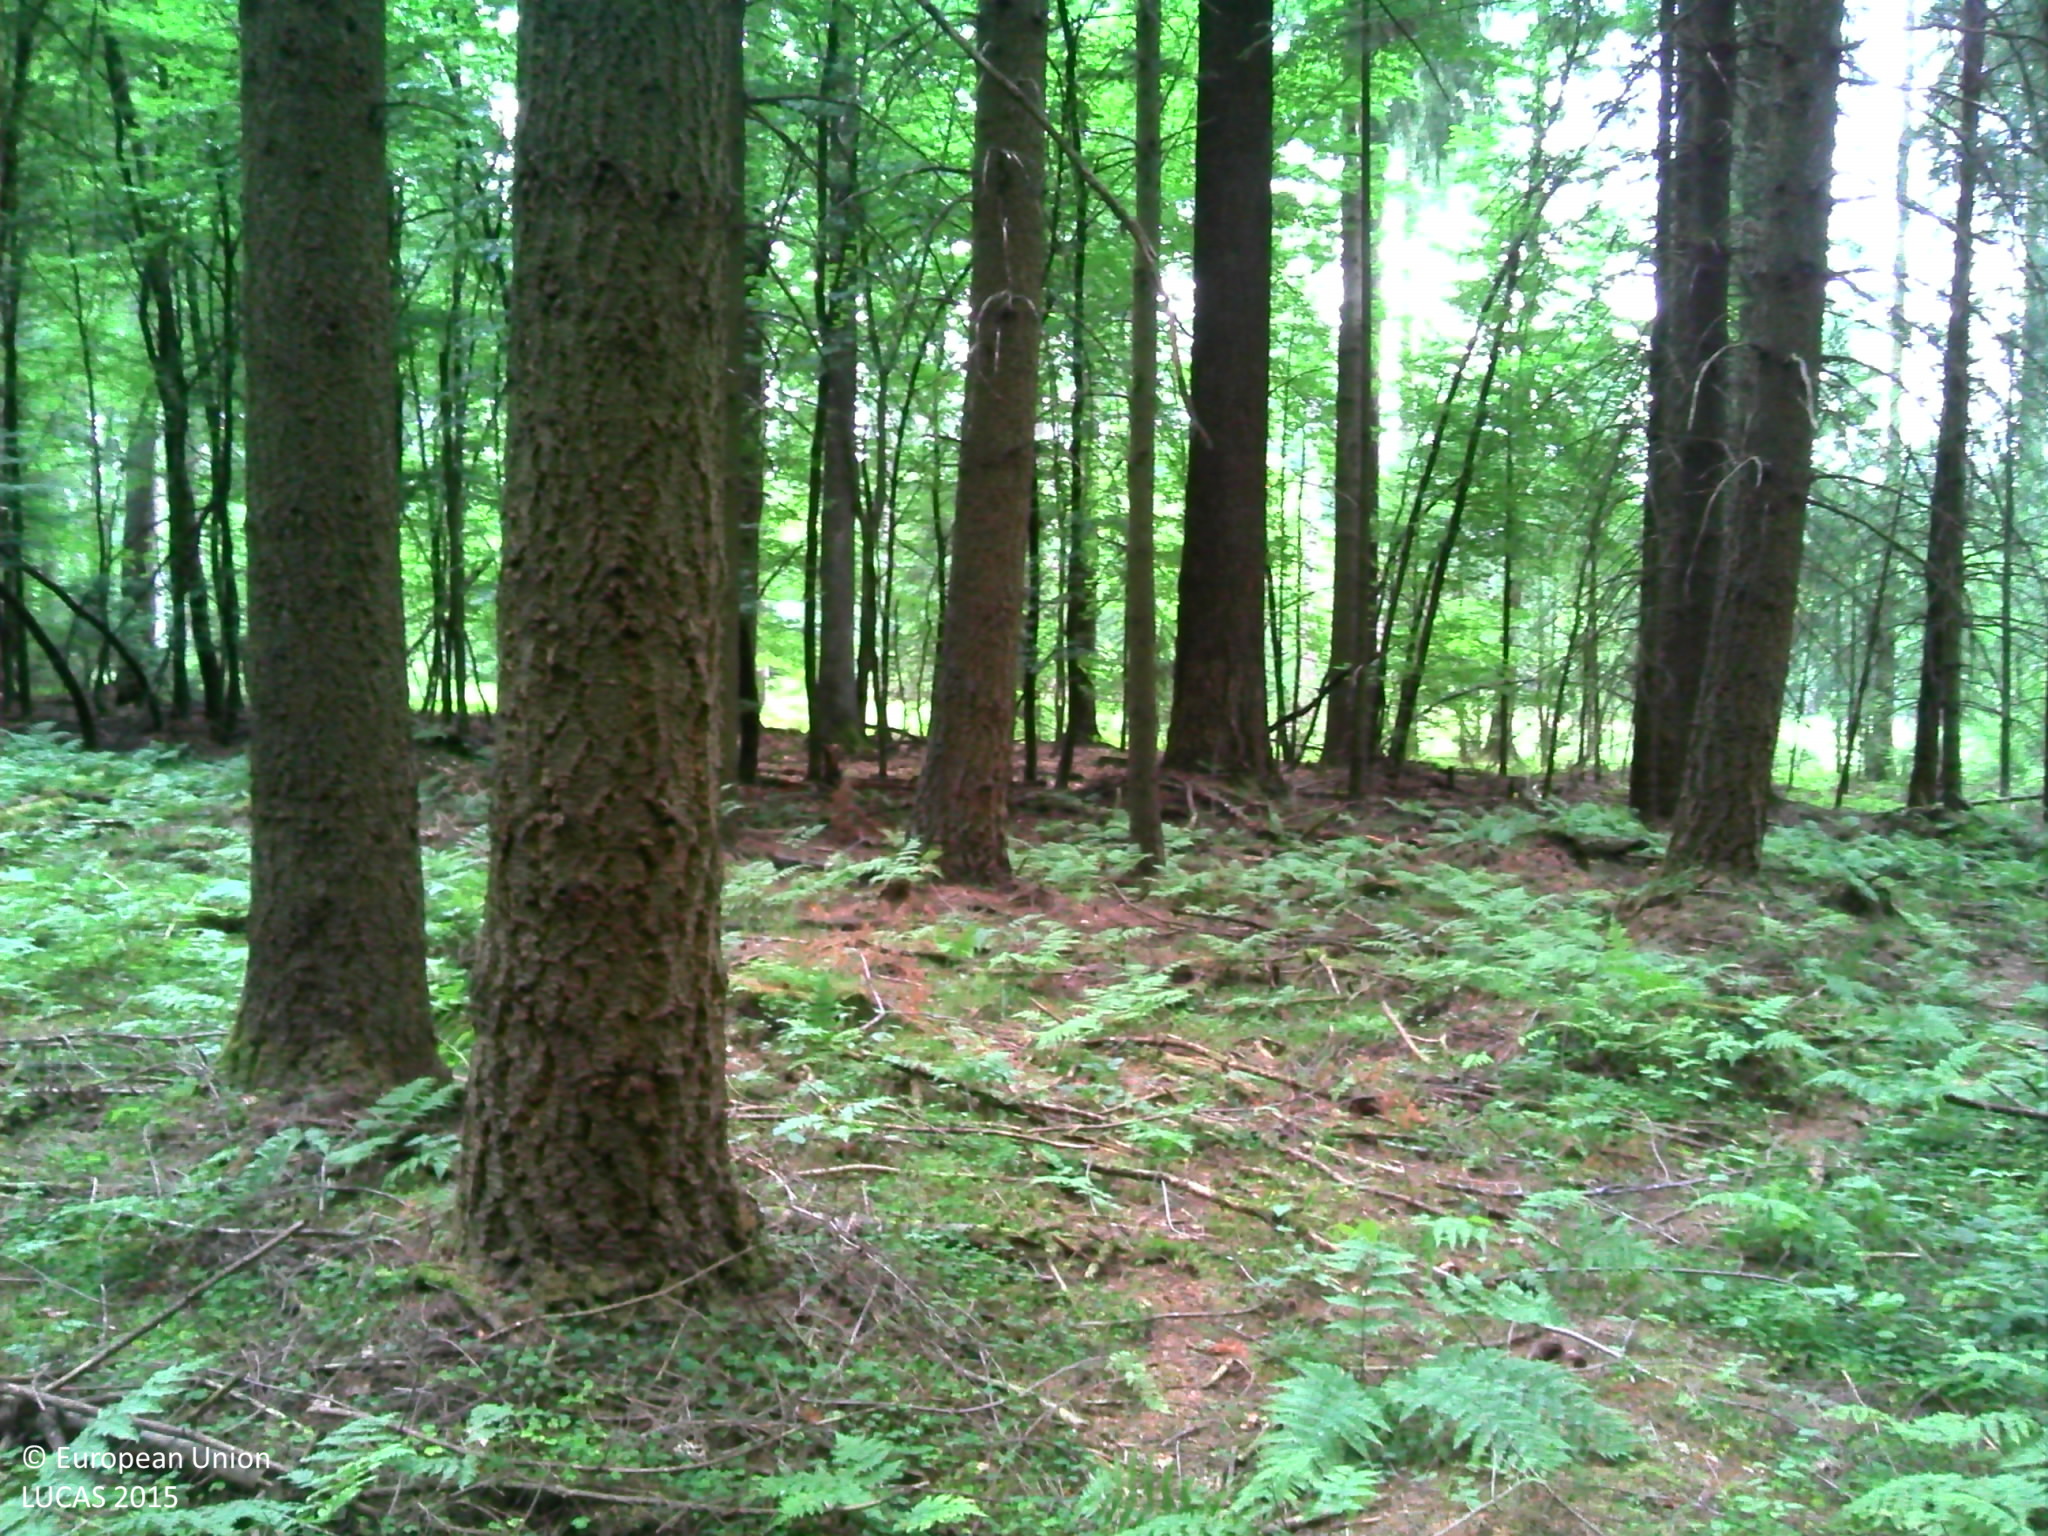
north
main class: Woodland
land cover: Other coniferous woodland
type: exotic forest
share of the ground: > 75 %
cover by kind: coniferous forest trees 95 %, herbaceous plants 5 %
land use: Forestry
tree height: > 5 m
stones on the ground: < 10 %
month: July
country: BE
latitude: 50.1963
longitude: 5.7822
